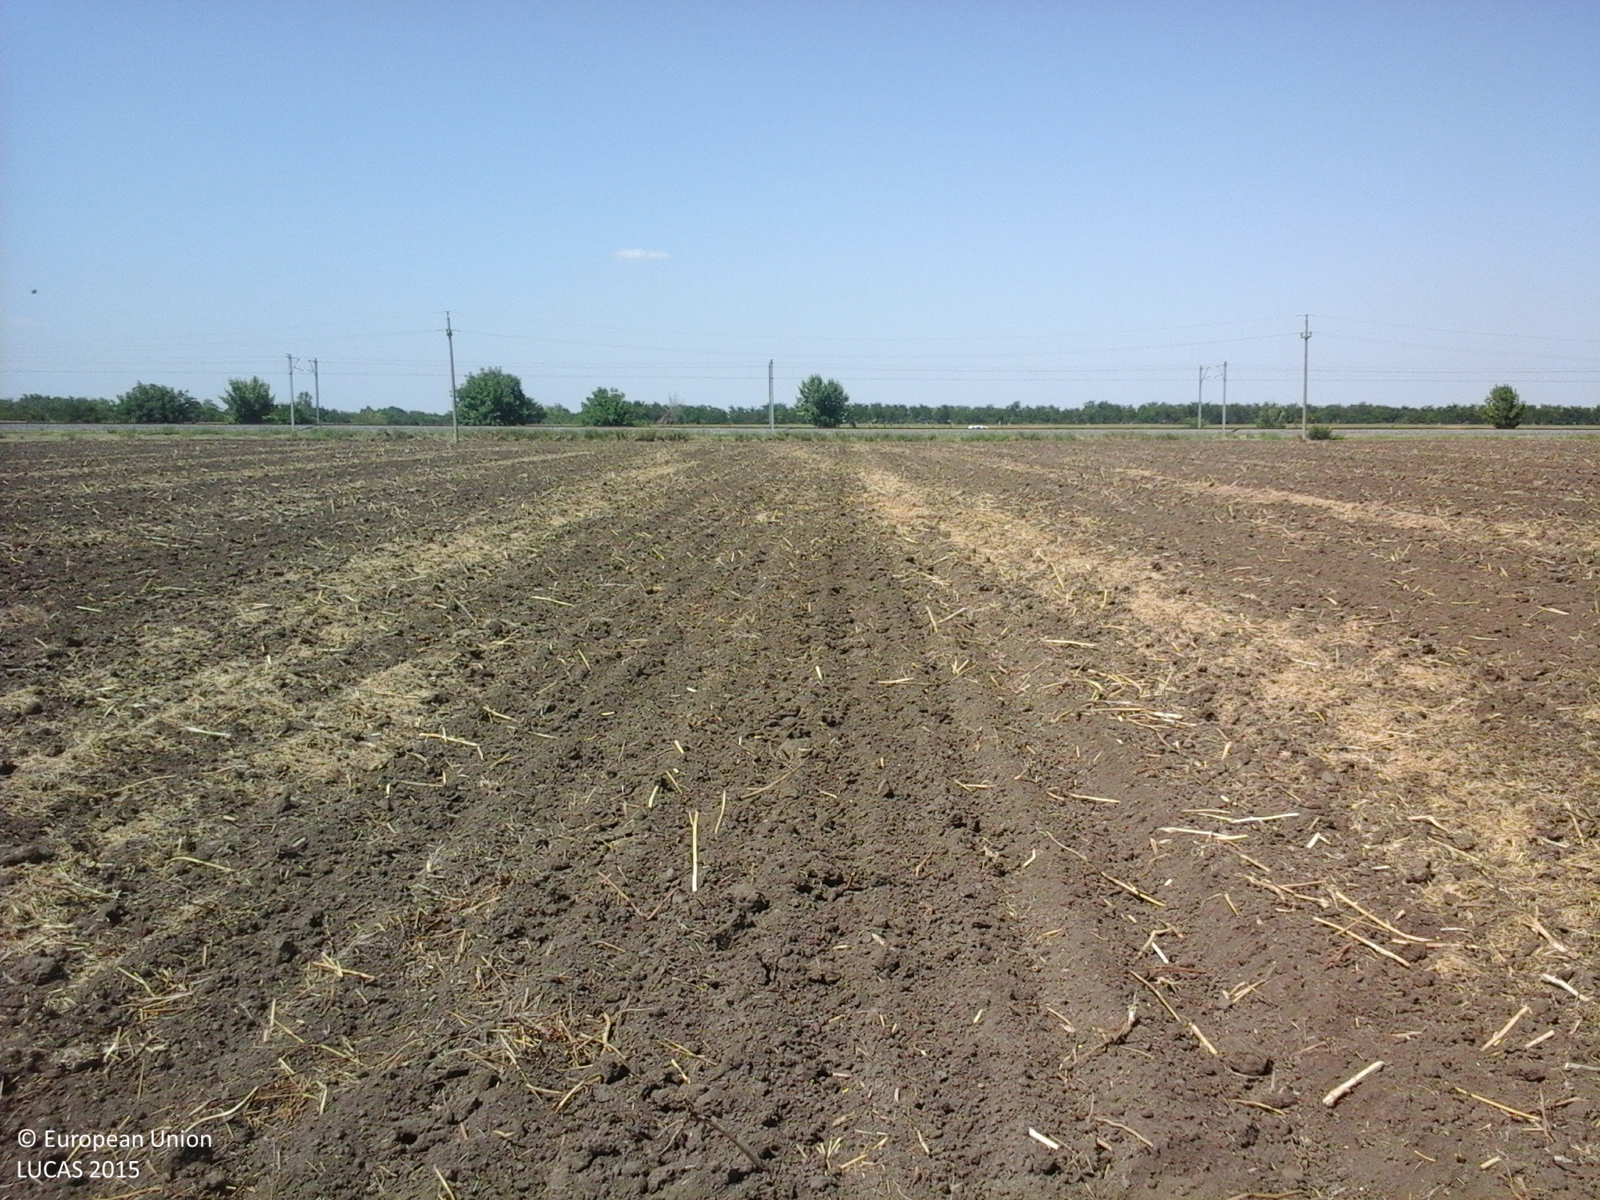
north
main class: Cropland
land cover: Rape and turnip rape
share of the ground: < 10 %
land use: Agriculture (excluding fallow land and kitchen gardens)
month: July
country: RO
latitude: 44.4313
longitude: 27.0767
